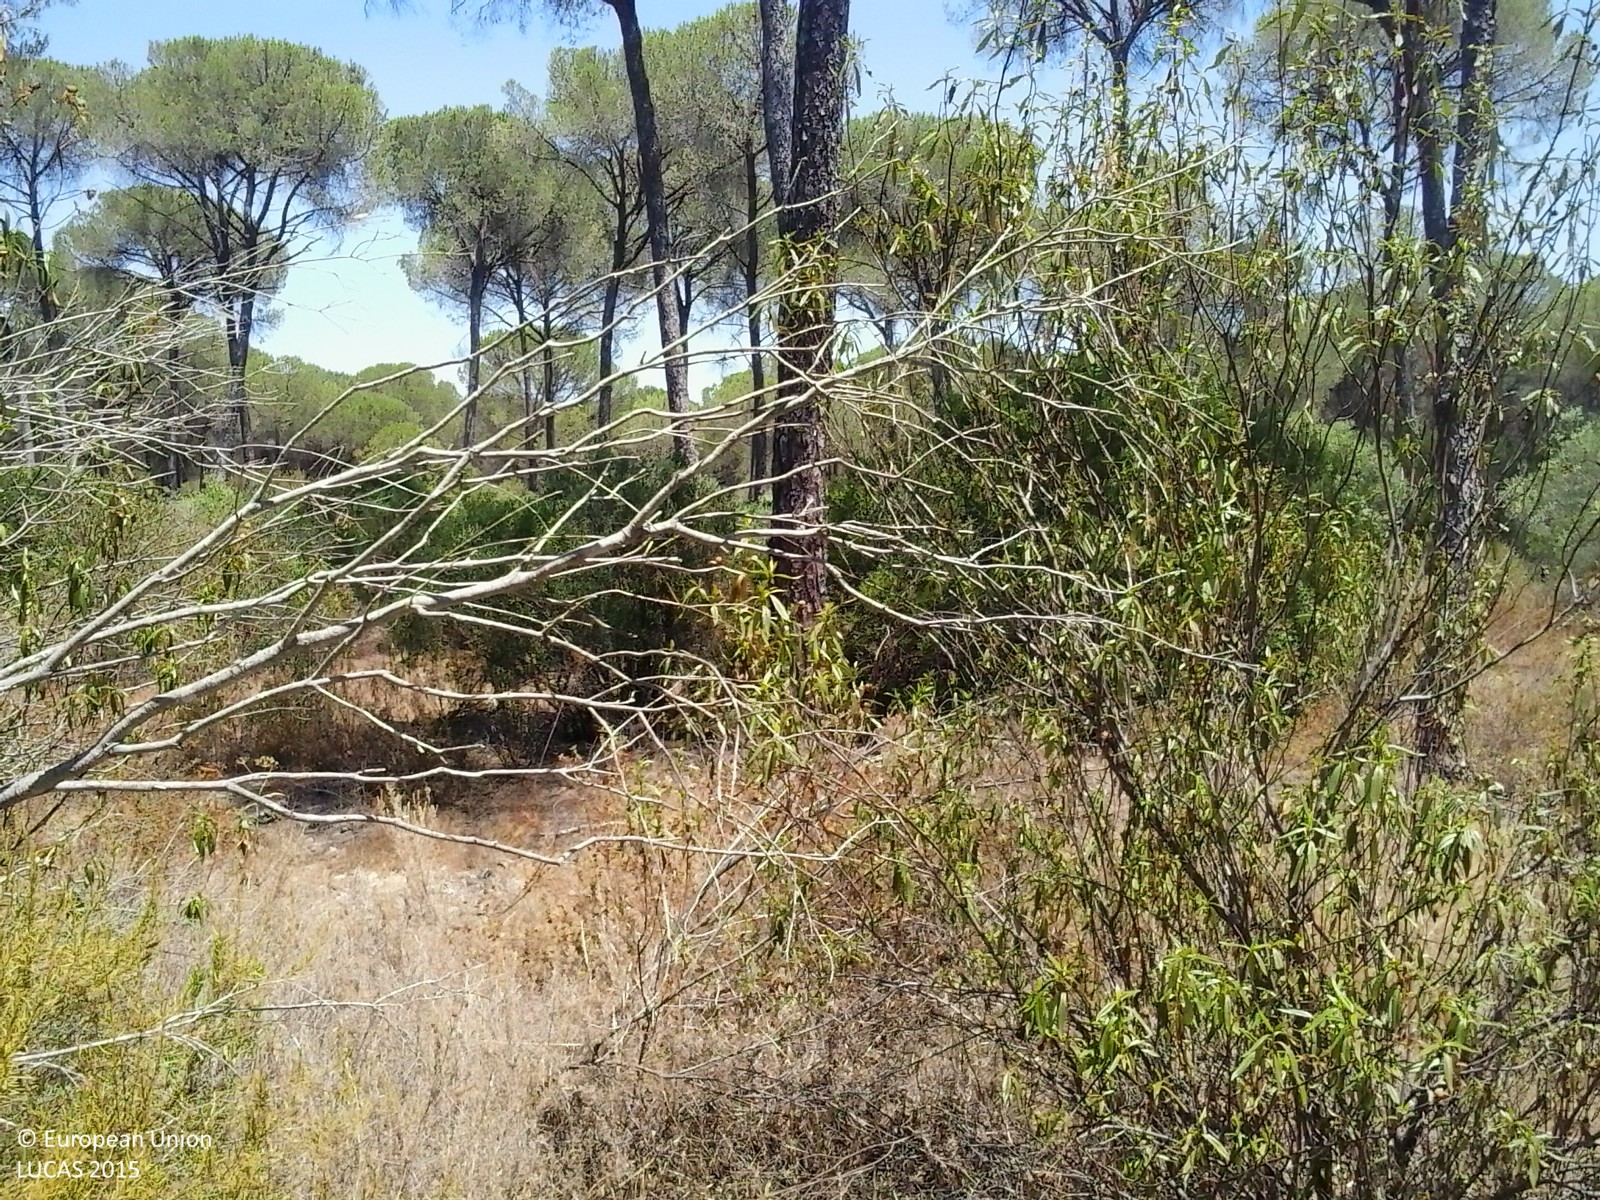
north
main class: Woodland
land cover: Pine dominated coniferous woodland
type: coniferous forest of the mediterranean region
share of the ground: 50 - 75 %
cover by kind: coniferous forest trees 80 %, shrubs 20 %
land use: Forestry
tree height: > 5 m
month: July
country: ES
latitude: 37.2134
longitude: -6.4234
